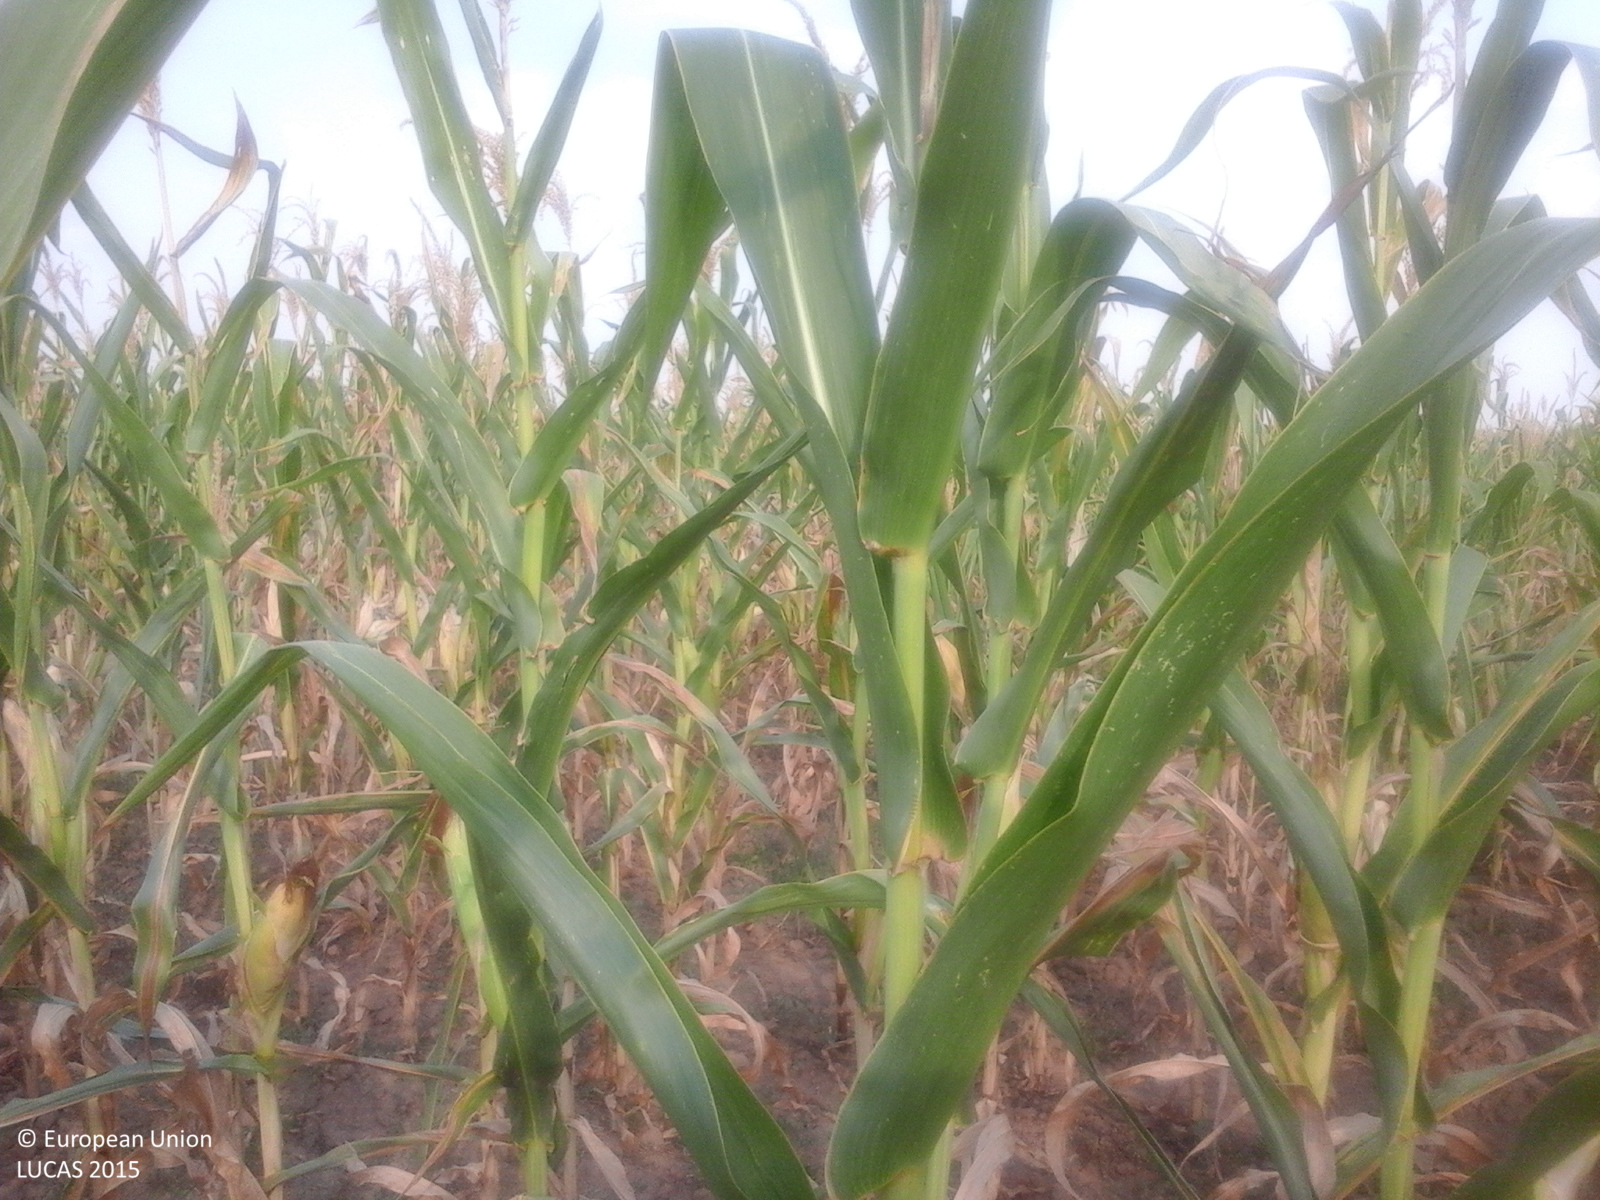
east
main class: Cropland
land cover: Maize
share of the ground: > 75 %
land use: Agriculture (excluding fallow land and kitchen gardens)
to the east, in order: Maize; Grass margins; Tracks; Grass margins; Common wheat; Maize; Common wheat; Sunflower; Temporary grasslands
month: August
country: RO
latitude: 44.2417
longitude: 22.6987
